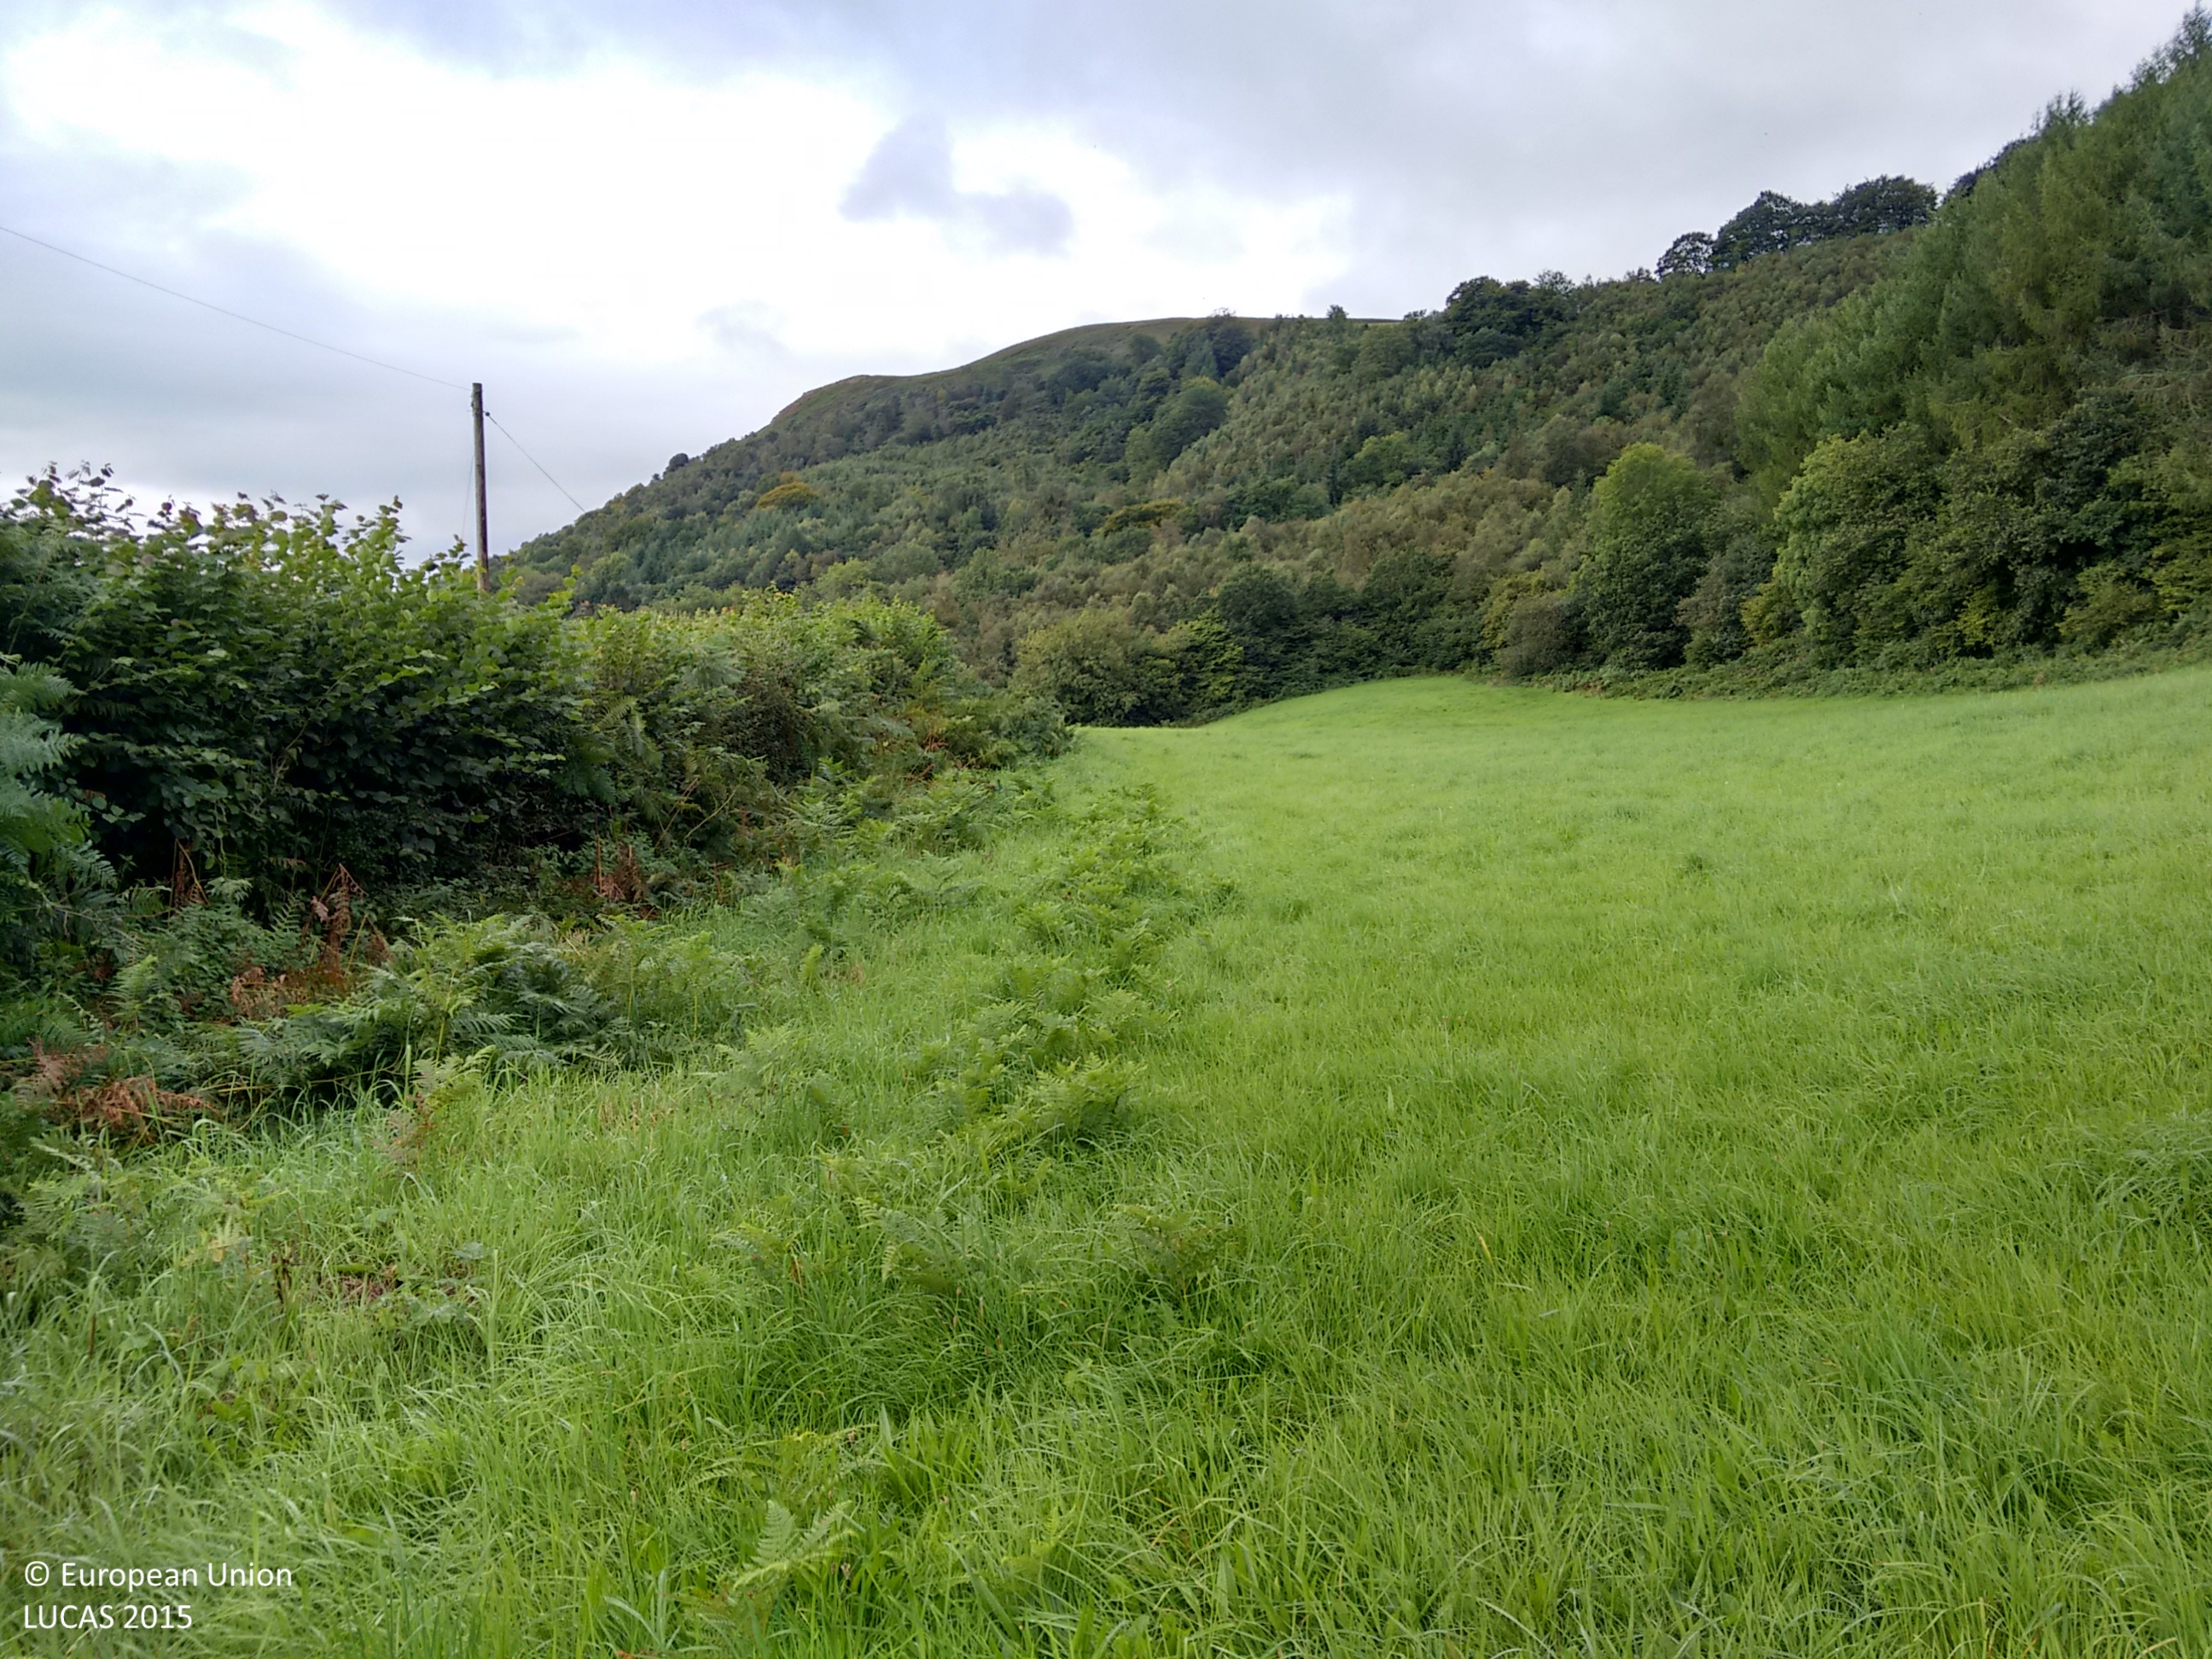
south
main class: Grassland
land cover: Grassland without tree/shrub cover
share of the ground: > 75 %
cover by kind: herbaceous plants 100 %
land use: Agriculture (excluding fallow land and kitchen gardens)
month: September
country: GB
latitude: 51.5544
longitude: -3.2770
